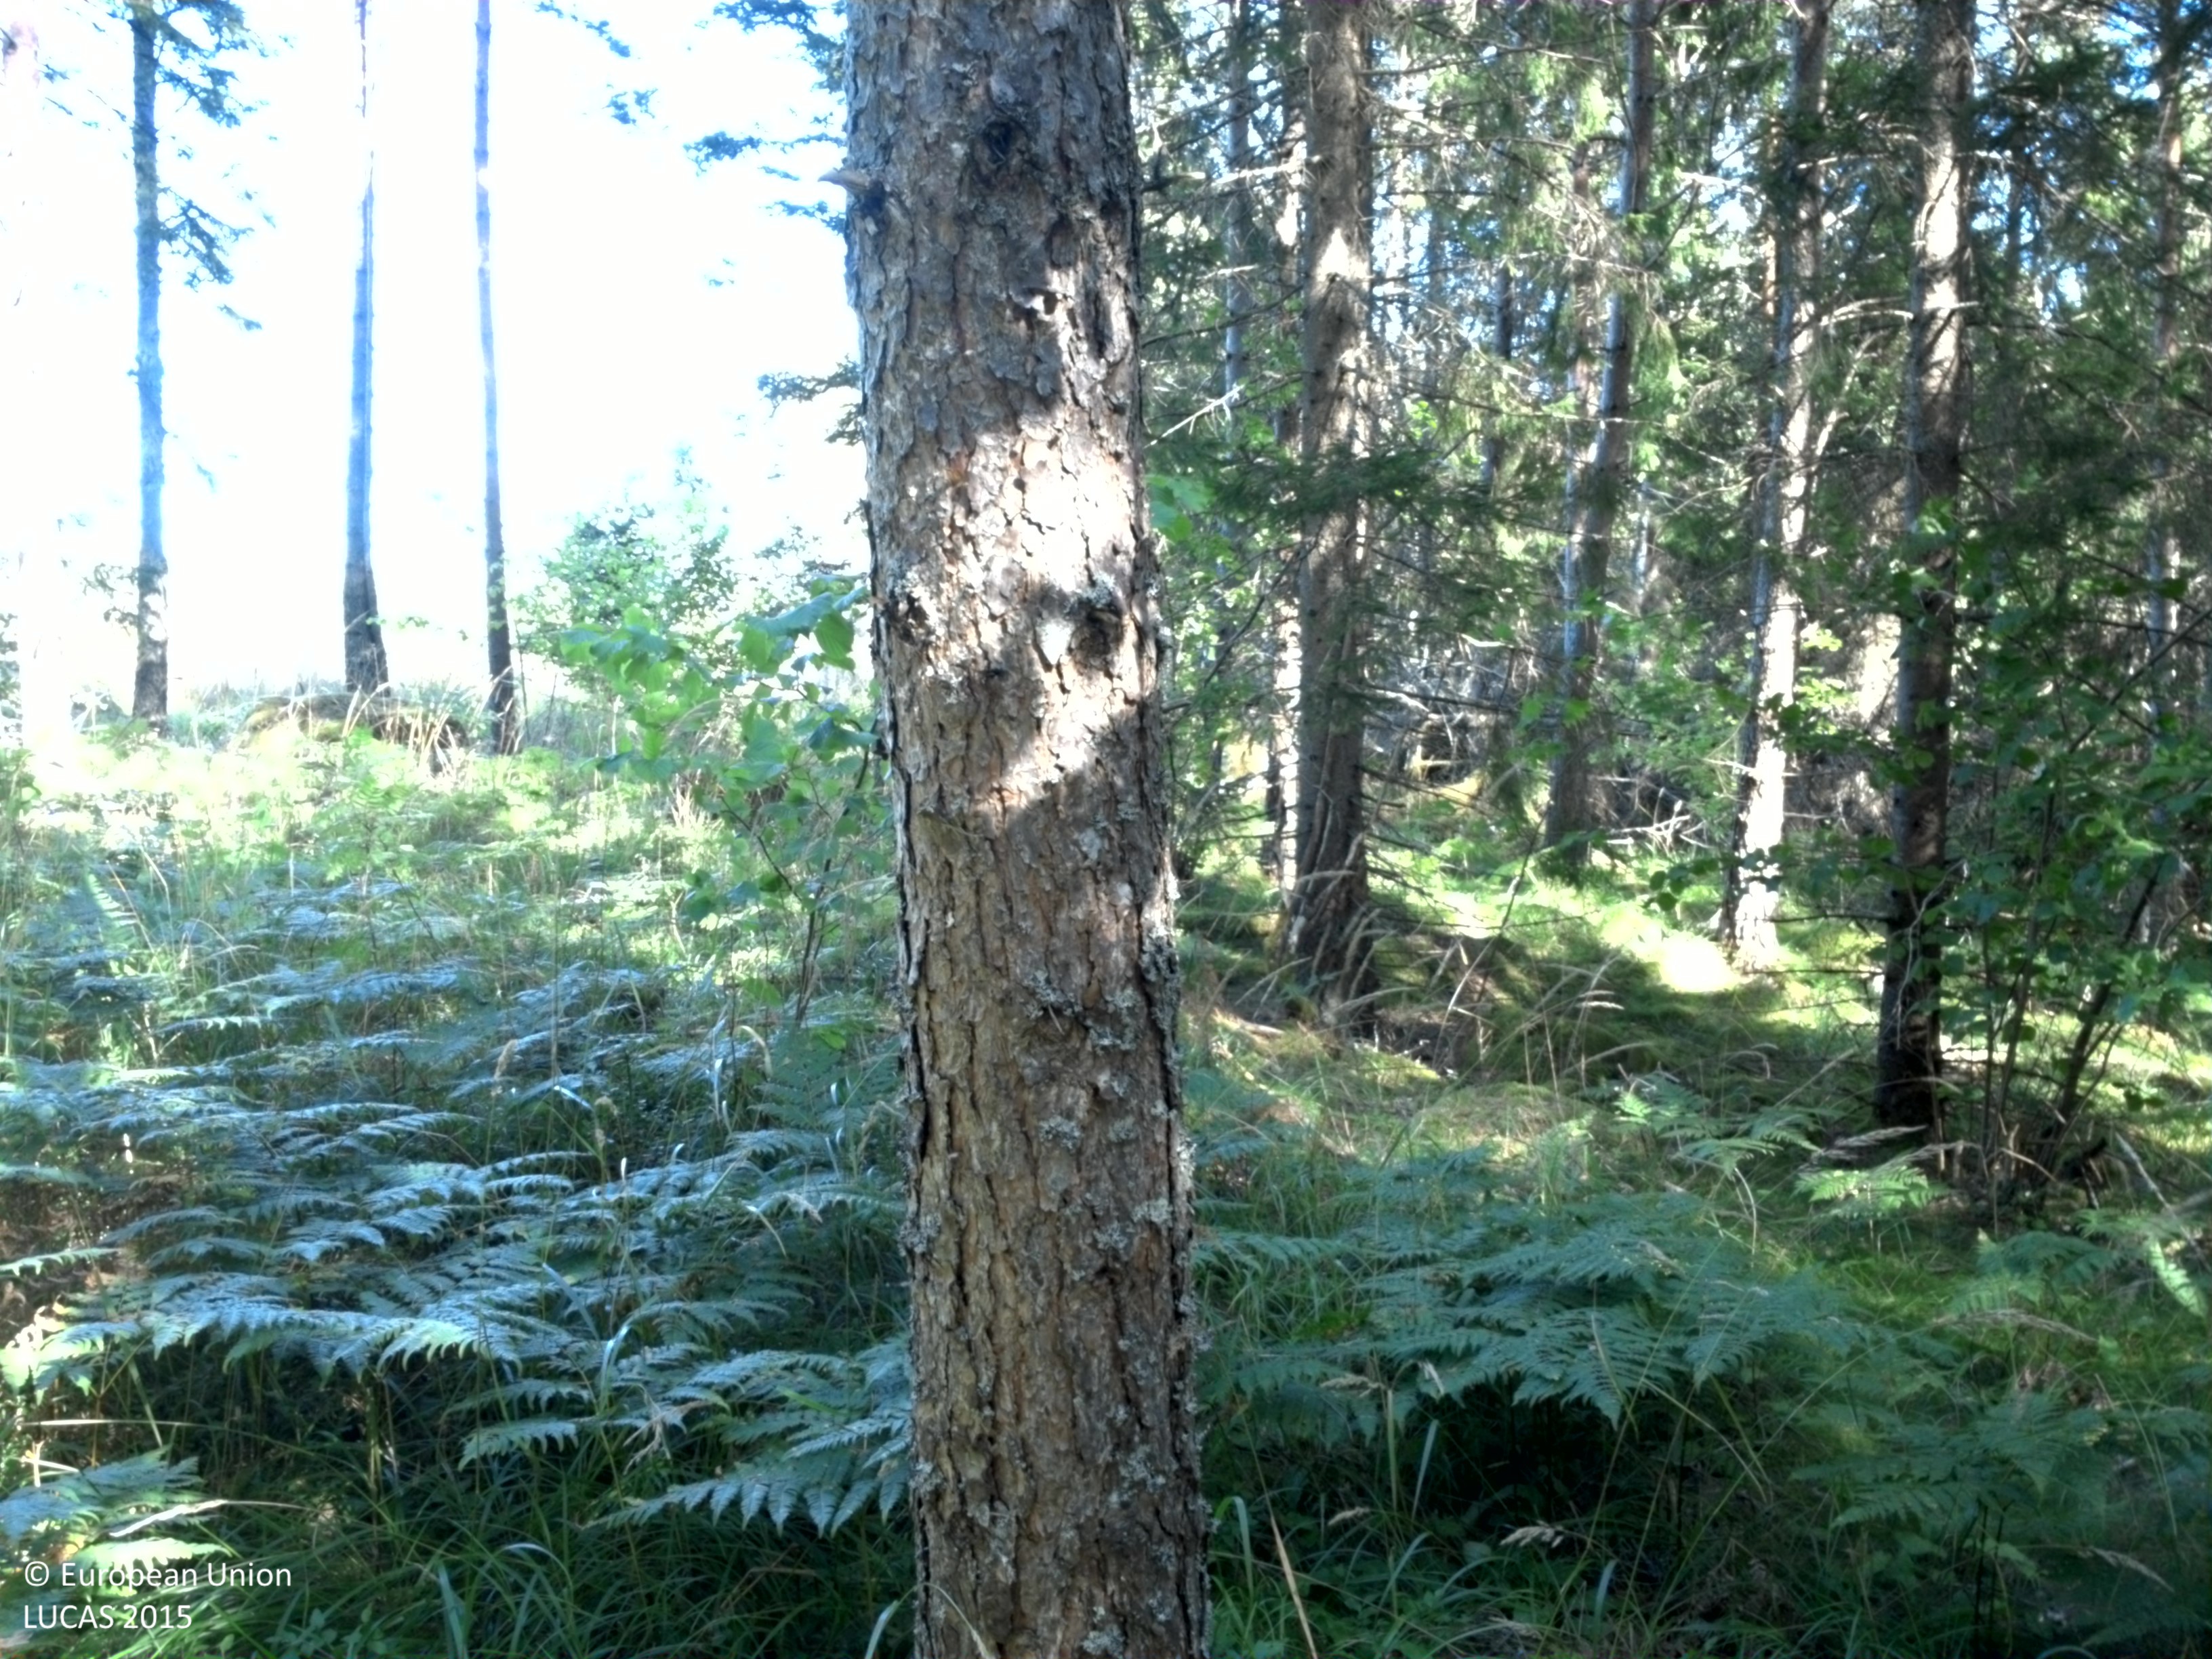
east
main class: Woodland
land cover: Pine dominated coniferous woodland
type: boreal forest
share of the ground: > 75 %
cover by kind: coniferous forest trees 70 %, shrubs 15 %, broadleaved forest trees 5 %, herbaceous plants 5 %, lichens and mosses 5 %
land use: Forestry
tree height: > 5 m
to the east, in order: Pine dominated coniferous woodland; Spruce dominated coniferous woodland; Ditches and canals; Paved roads, cycling and walking lanes; Ditches and canals; Broadleaved woodland; Grassland without tree/shrub cover; Spruce dominated coniferous woodland; Spruce dominated mixed woodland; Spruce dominated coniferous woodland
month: August
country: SE
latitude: 59.9713
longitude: 18.0032
